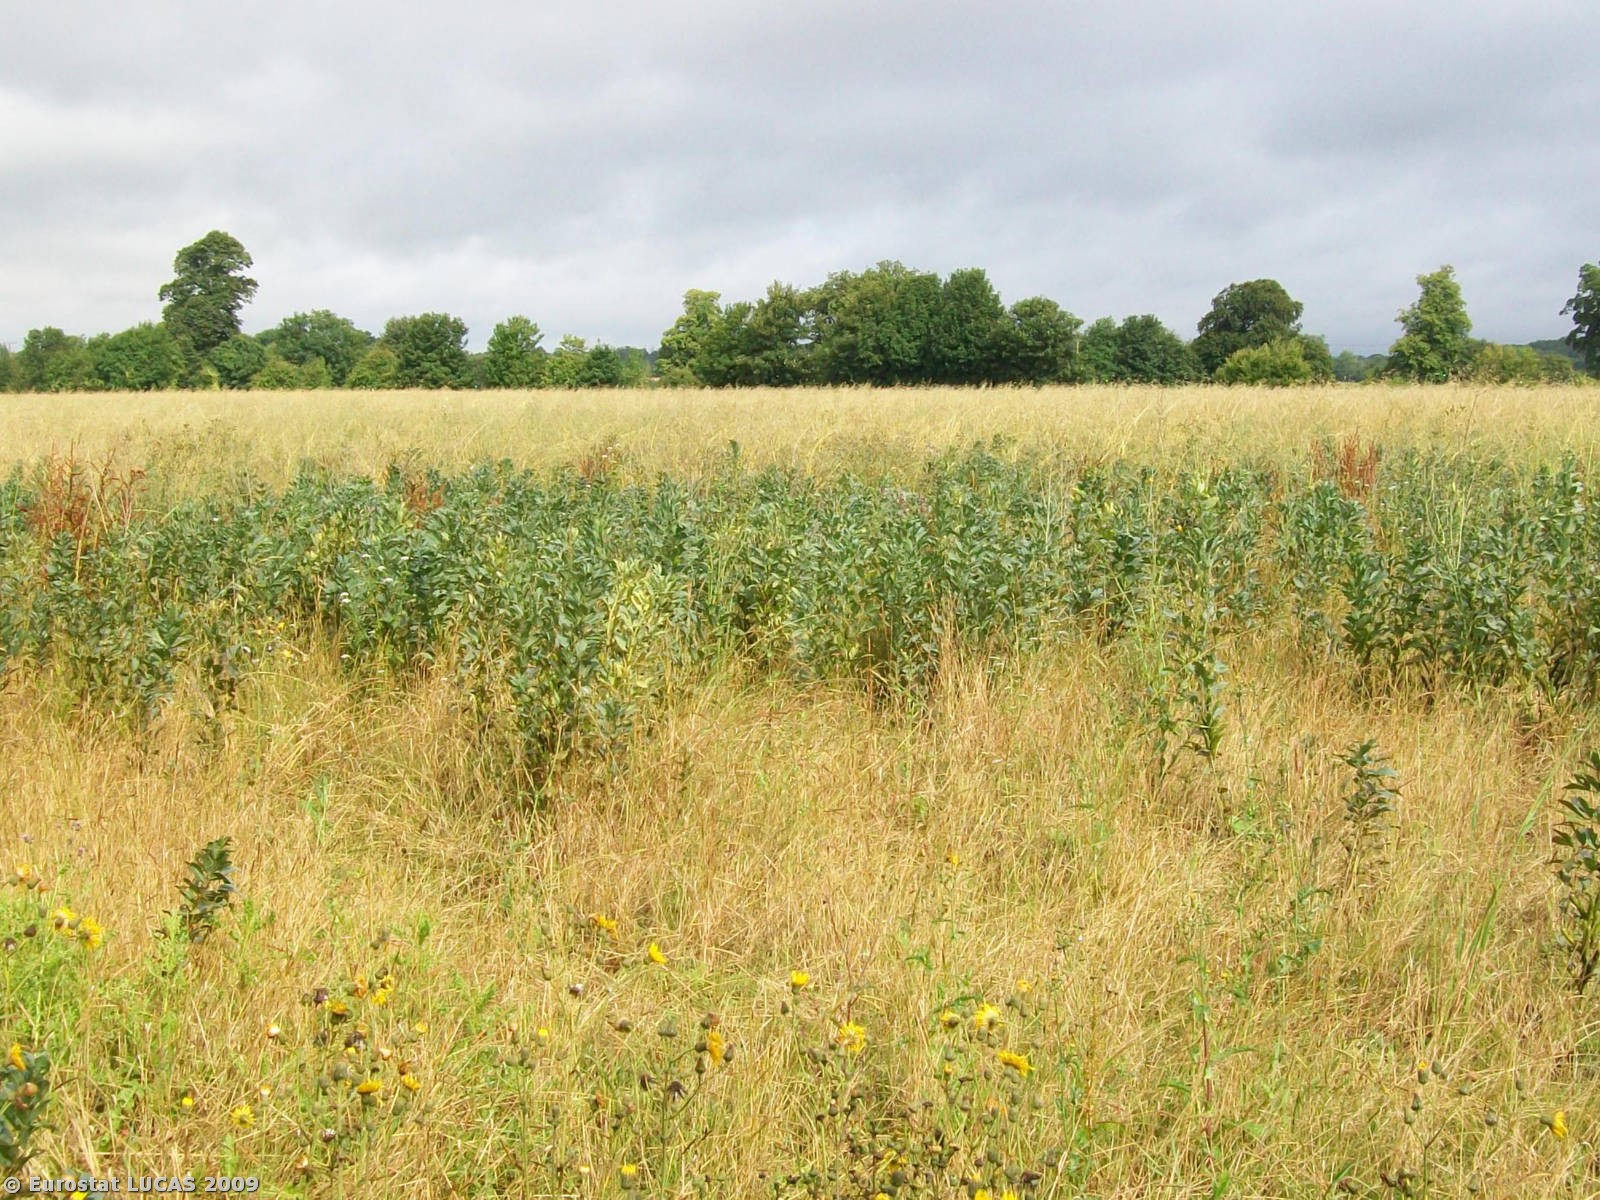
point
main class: Cropland
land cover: Dry pulses
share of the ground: > 75 %
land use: Agriculture (excluding fallow land and kitchen gardens)
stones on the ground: < 10 %
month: July
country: GB
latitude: 51.5080
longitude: -2.2077
